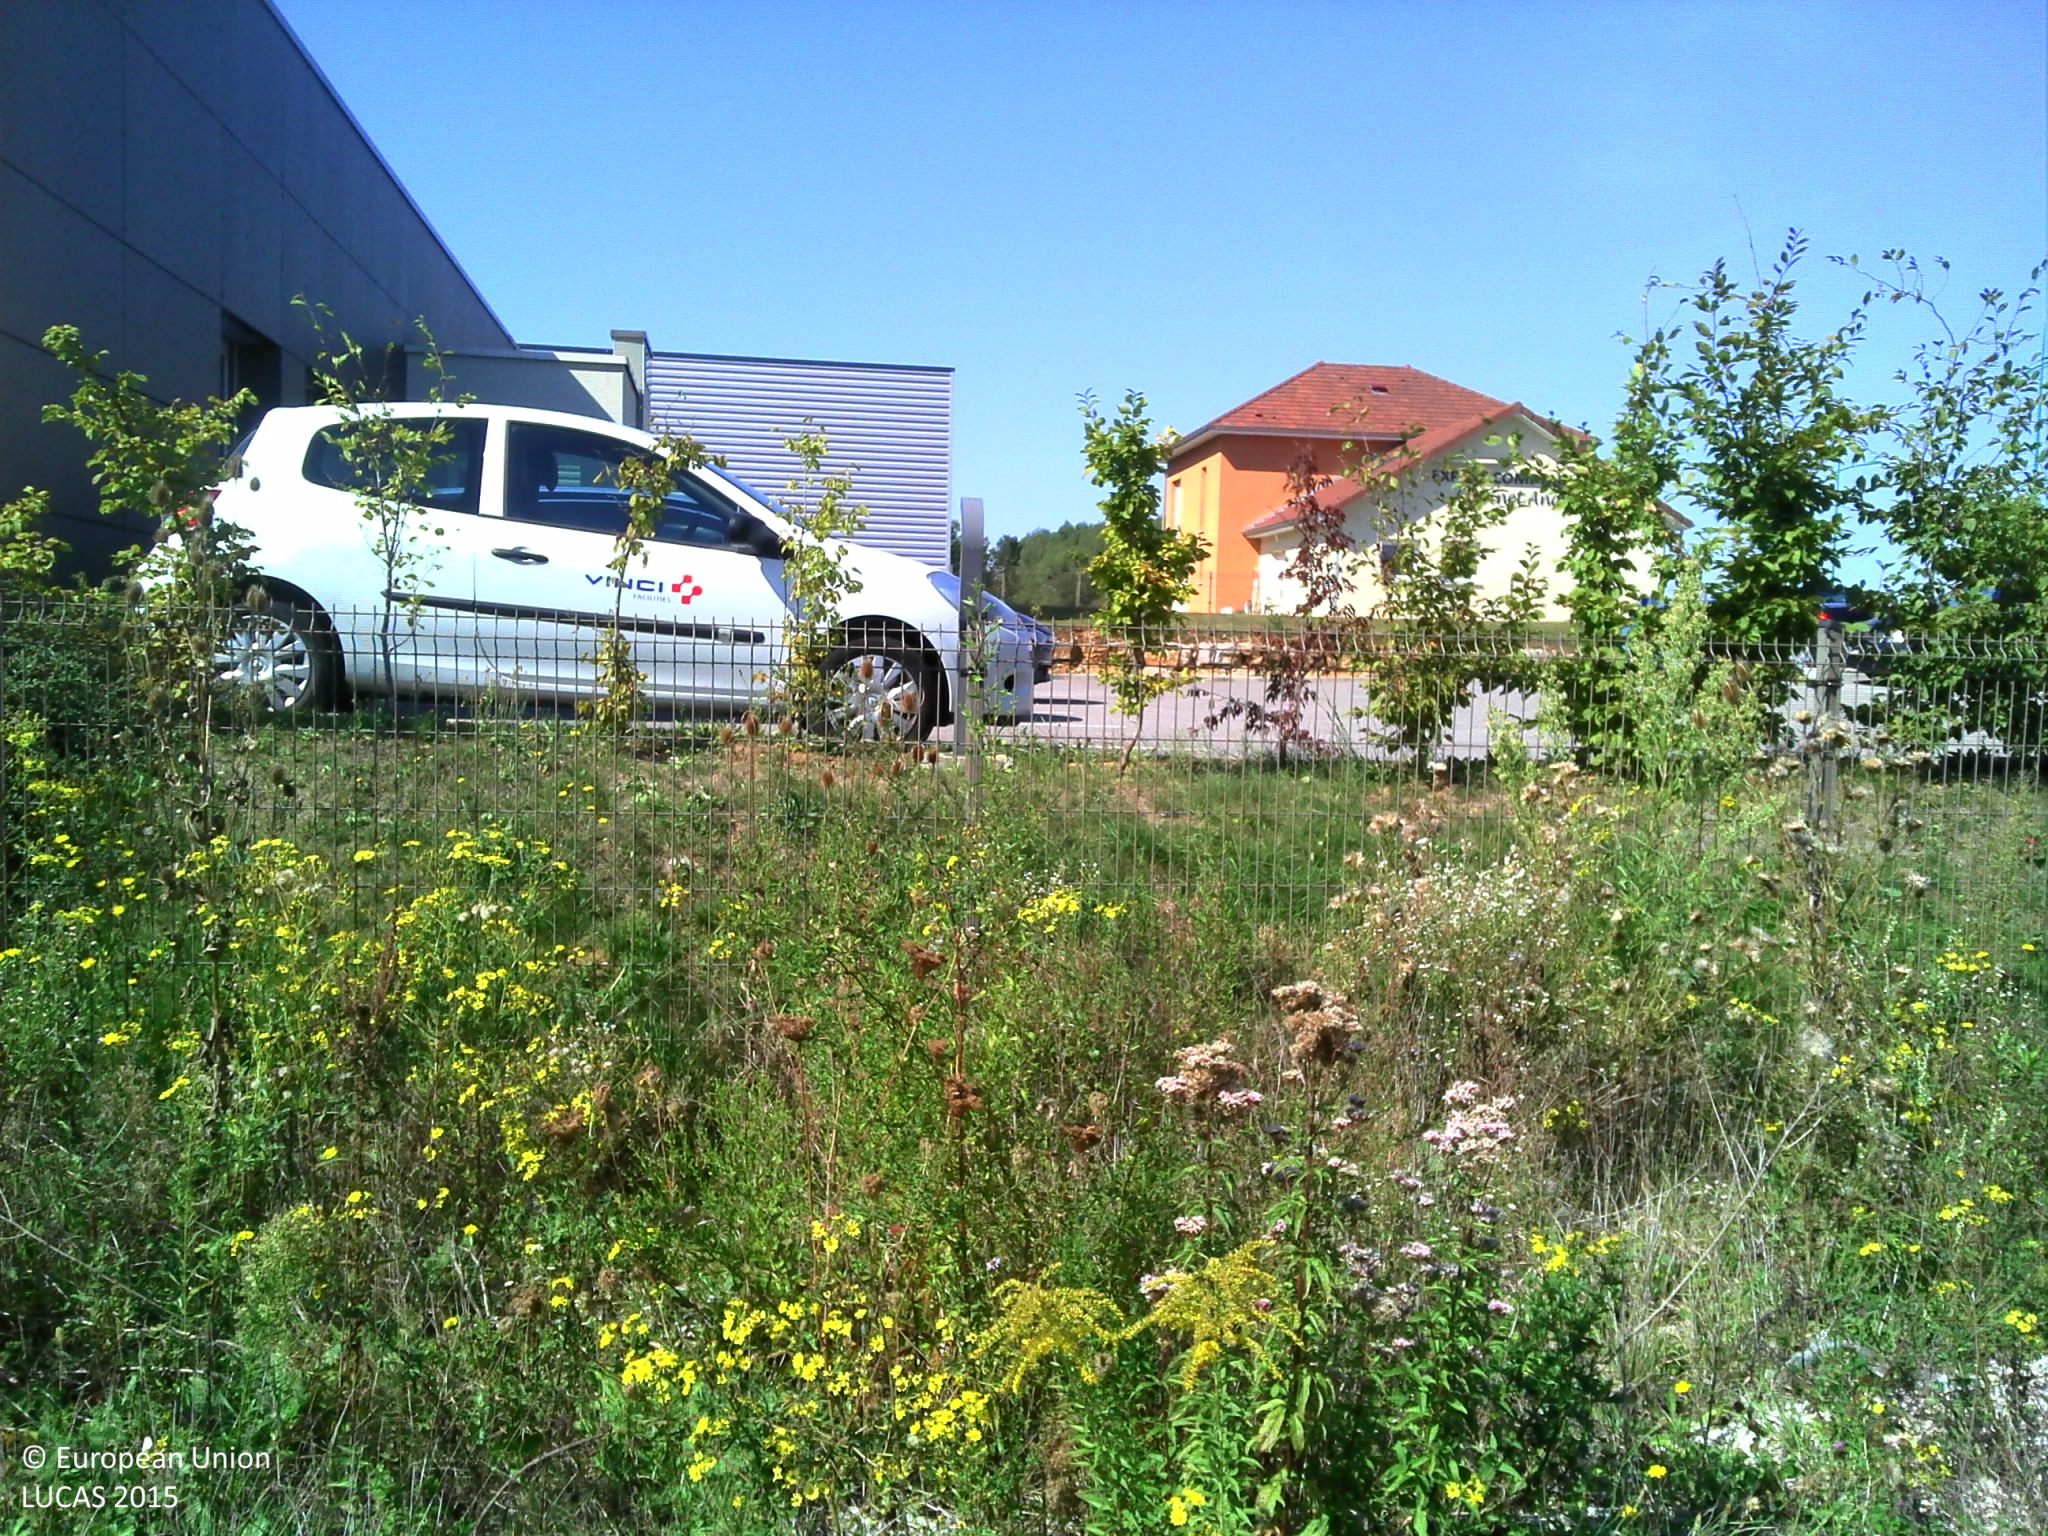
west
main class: Grassland
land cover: Spontaneously vegetated surfaces
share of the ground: > 75 %
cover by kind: herbaceous plants 95 %, shrubs 5 %
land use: Commerce
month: September
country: FR
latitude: 47.2717
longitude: 6.1024
